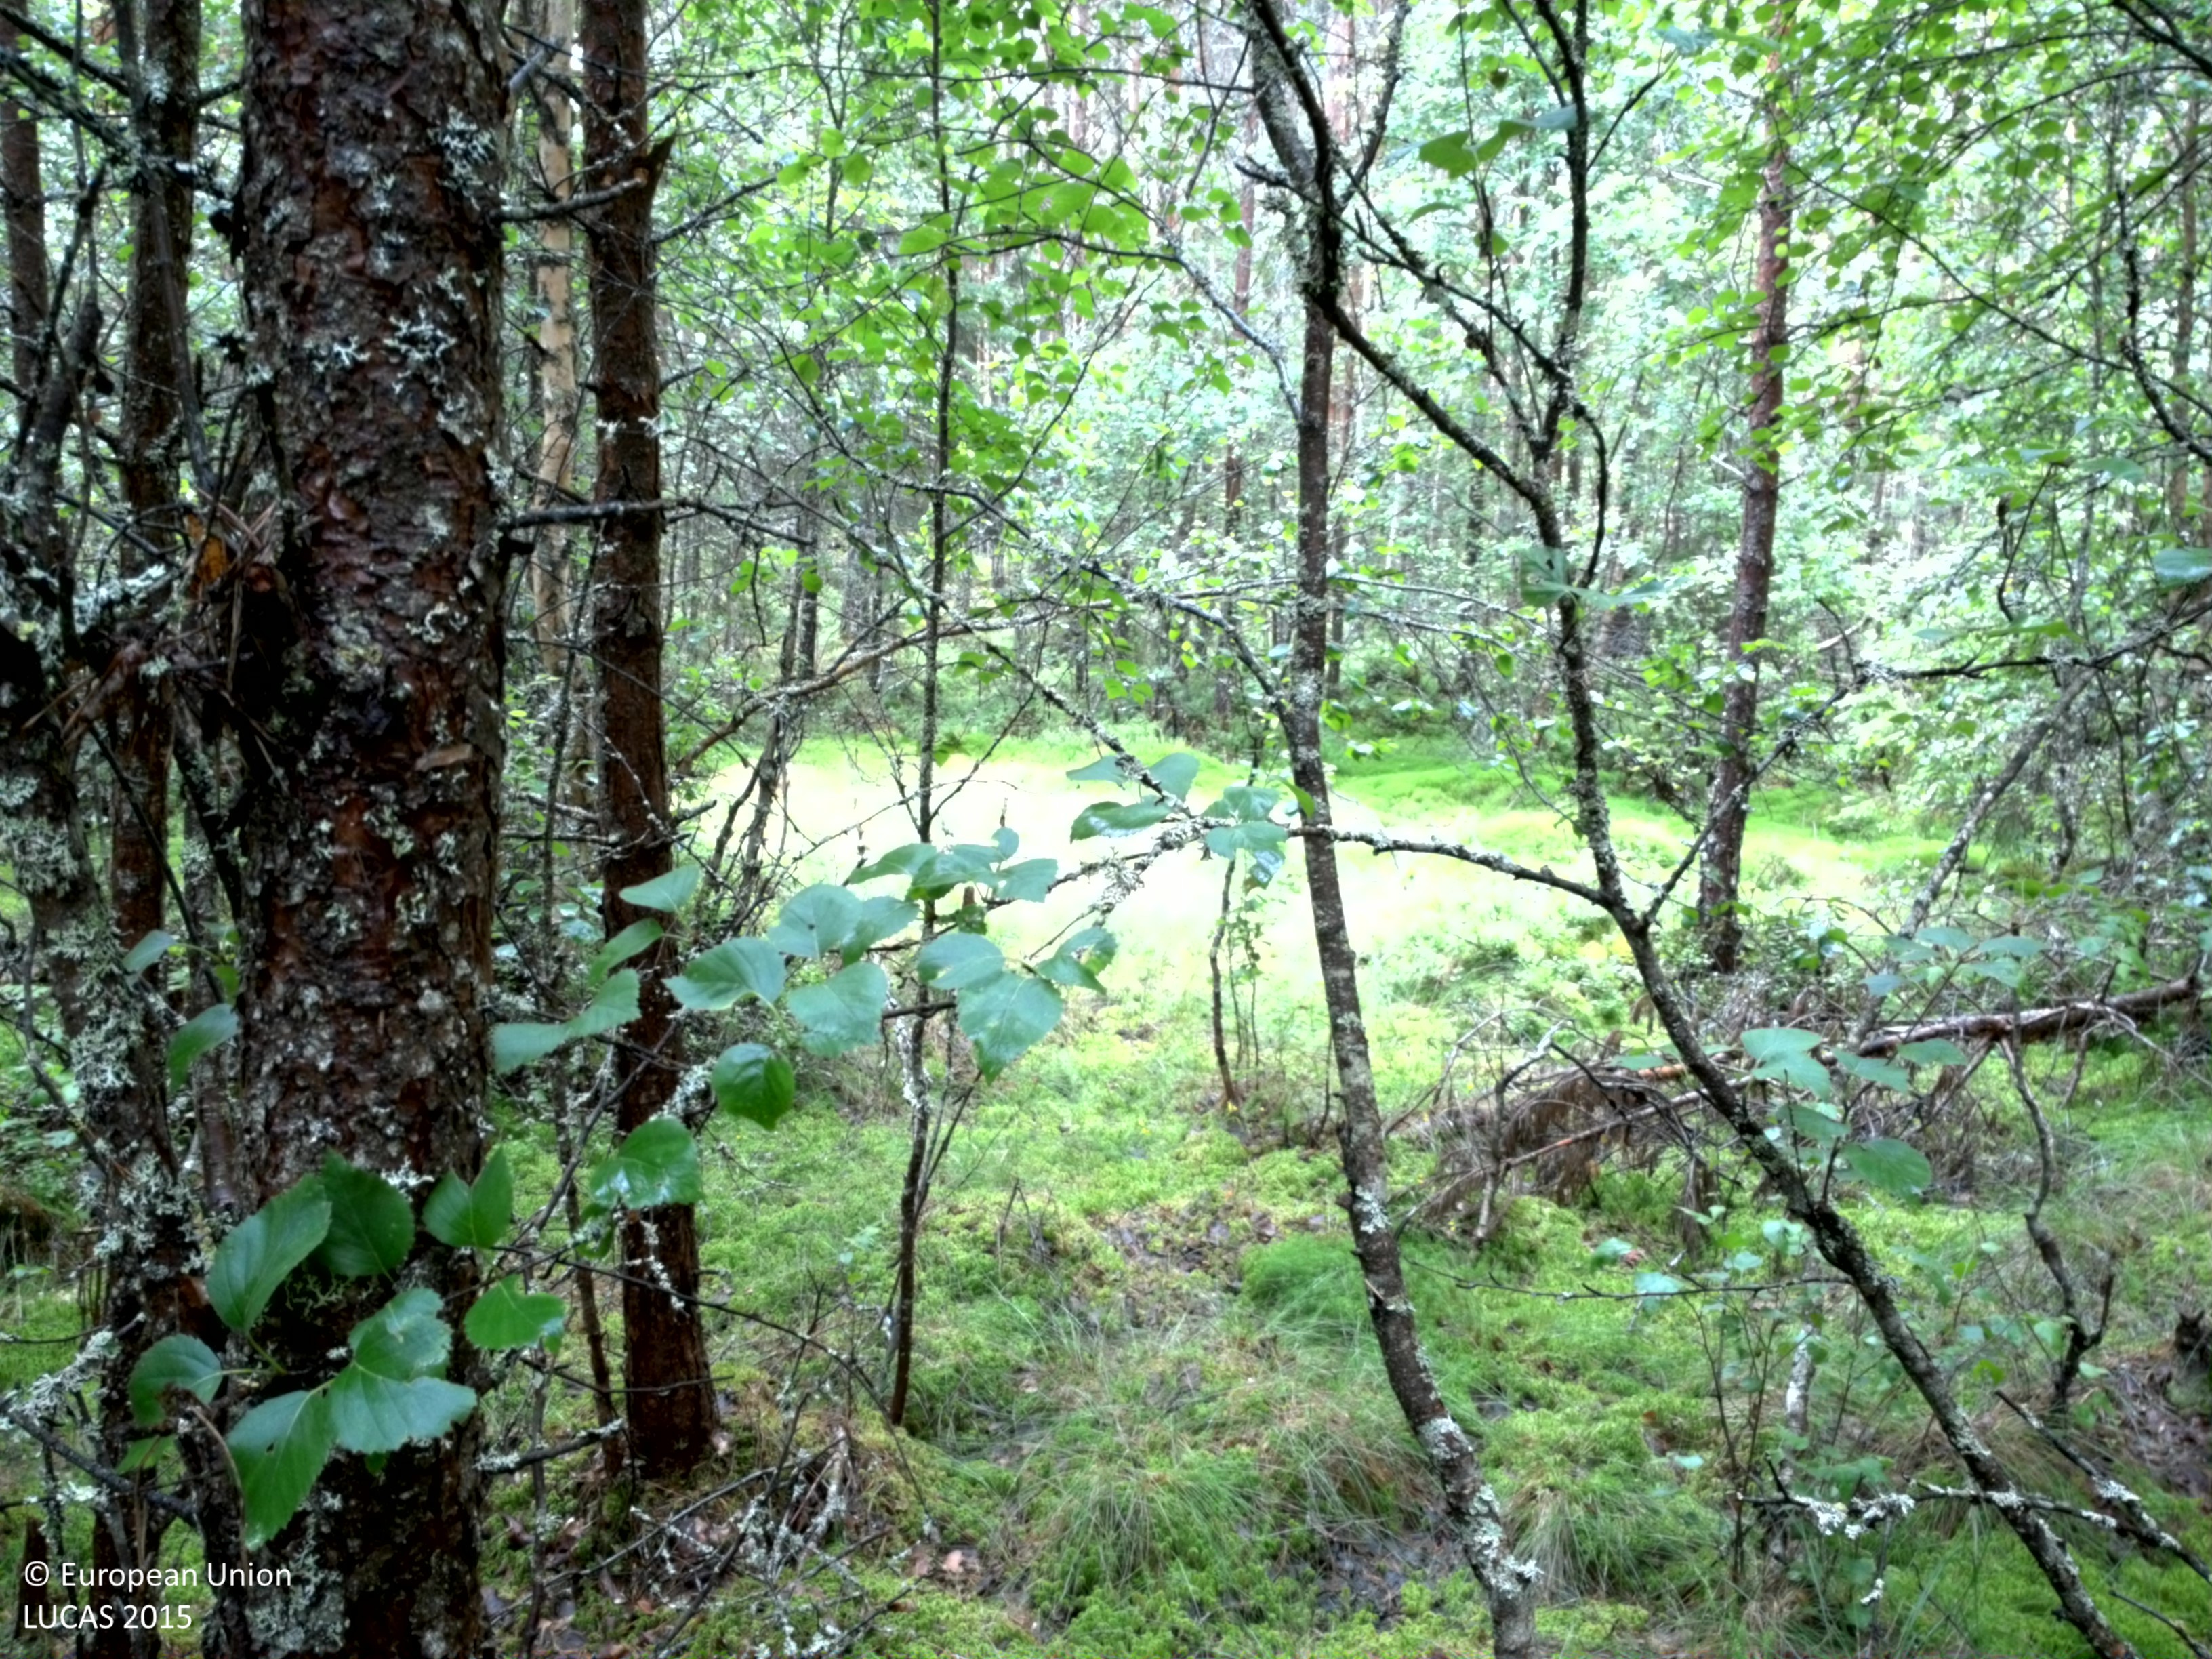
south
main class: Woodland
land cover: Pine dominated mixed woodland
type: boreal forest
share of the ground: > 75 %
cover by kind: coniferous forest trees 55 %, broadleaved forest trees 25 %, lichens and mosses 20 %
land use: Forestry
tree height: > 5 m
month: July
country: SE
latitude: 60.0192
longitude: 17.1143
